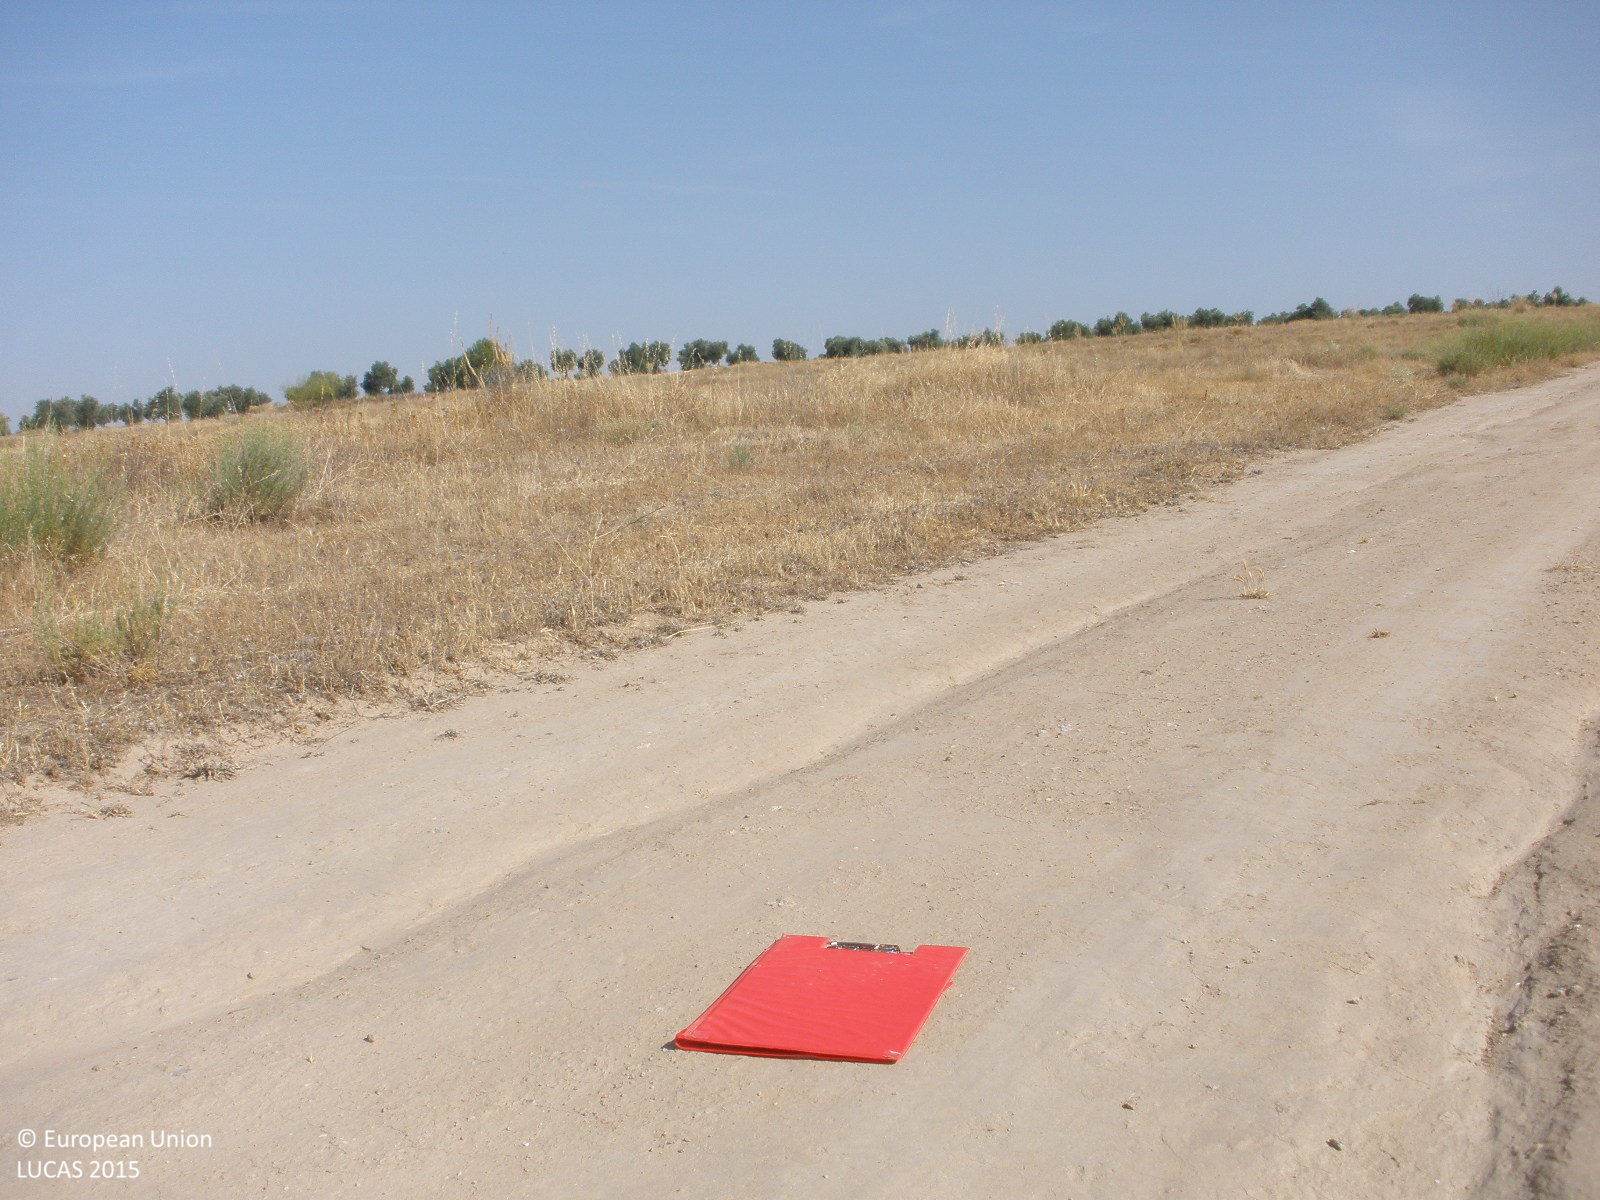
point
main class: Shrubland
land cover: Shrubland without tree cover
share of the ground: 25 - 50 %
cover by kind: herbaceous plants 50 %, shrubs 30 %, consolidated bare surface 20 %
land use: Semi-natural and natural areas not in use
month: July
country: ES
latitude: 40.0976
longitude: -3.5086
